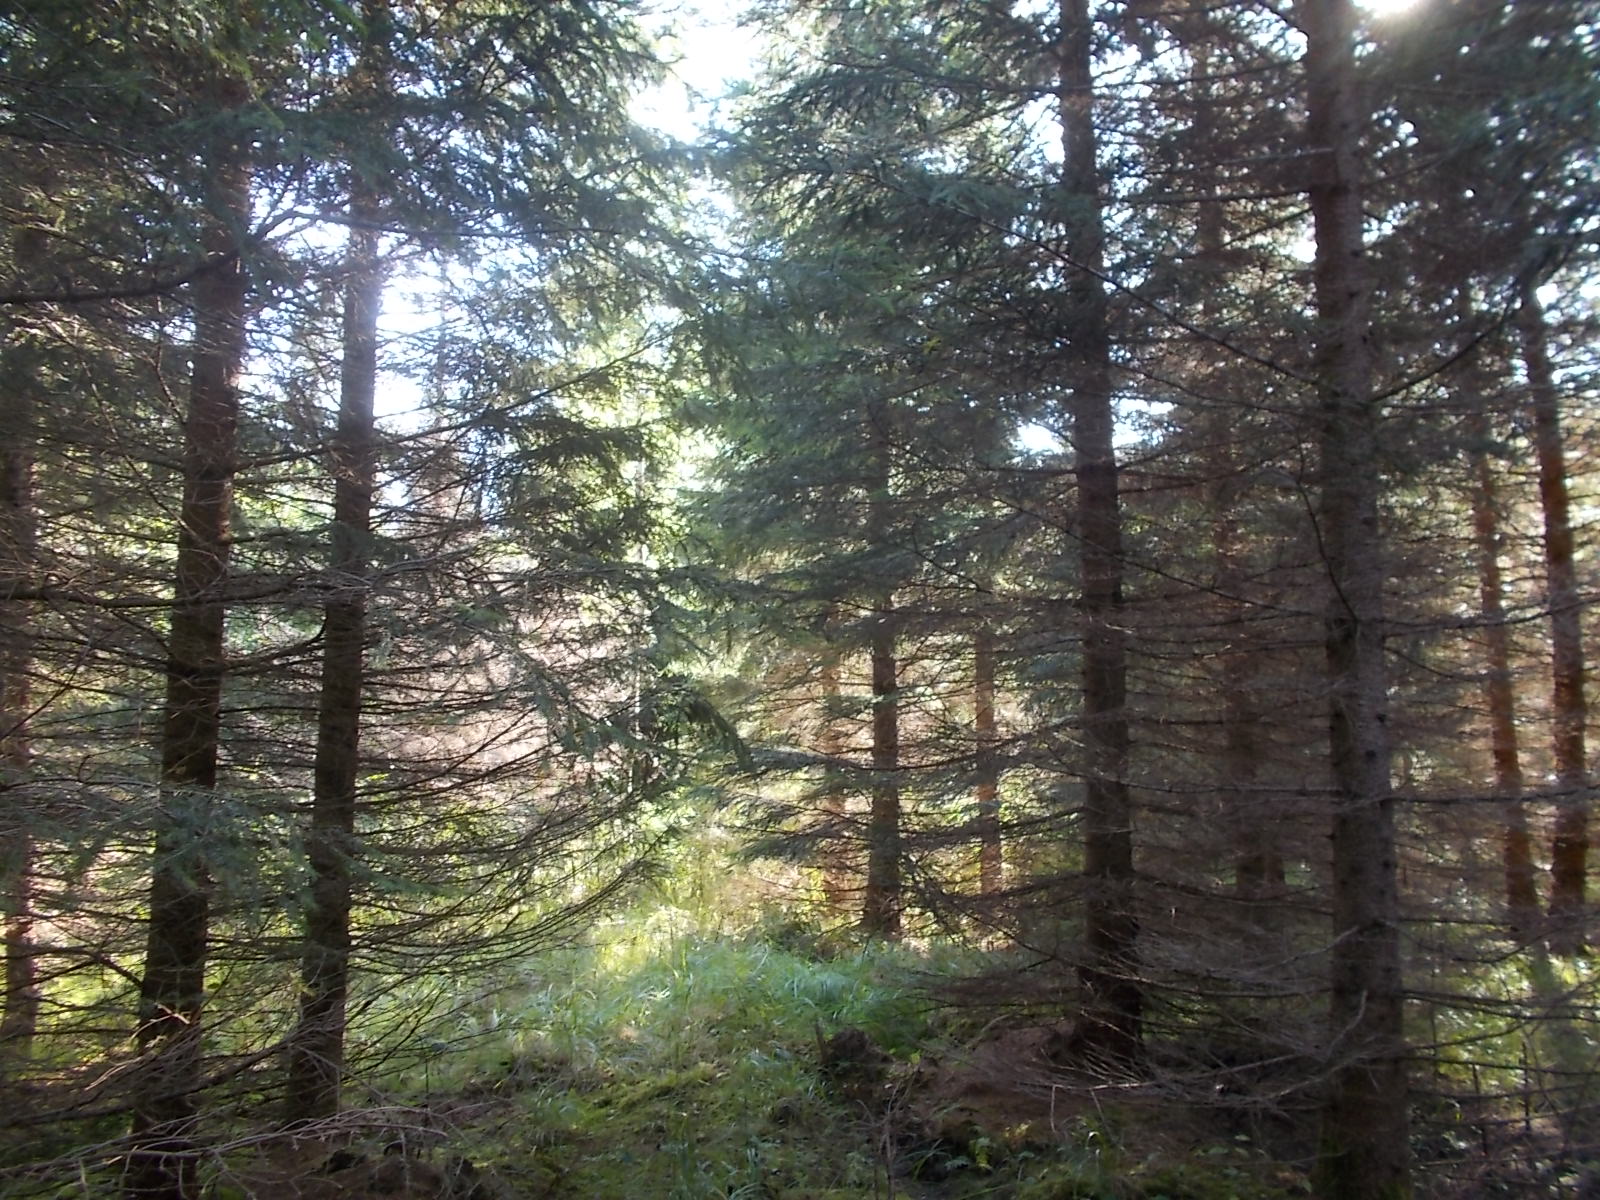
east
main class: Woodland
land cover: Spruce dominated coniferous woodland
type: hemiboreal forest and nemoral coniferous forest and mixed broadleaved-coniferous forest
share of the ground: 50 - 75 %
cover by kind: coniferous forest trees 70 %, shrubs 10 %, herbaceous plants 10 %, lichens and mosses 10 %
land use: Forestry
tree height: > 5 m
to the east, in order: Spruce dominated coniferous woodland; Rivers and streams; Spruce dominated coniferous woodland
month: August
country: LV
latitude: 57.0541
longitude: 22.0668
